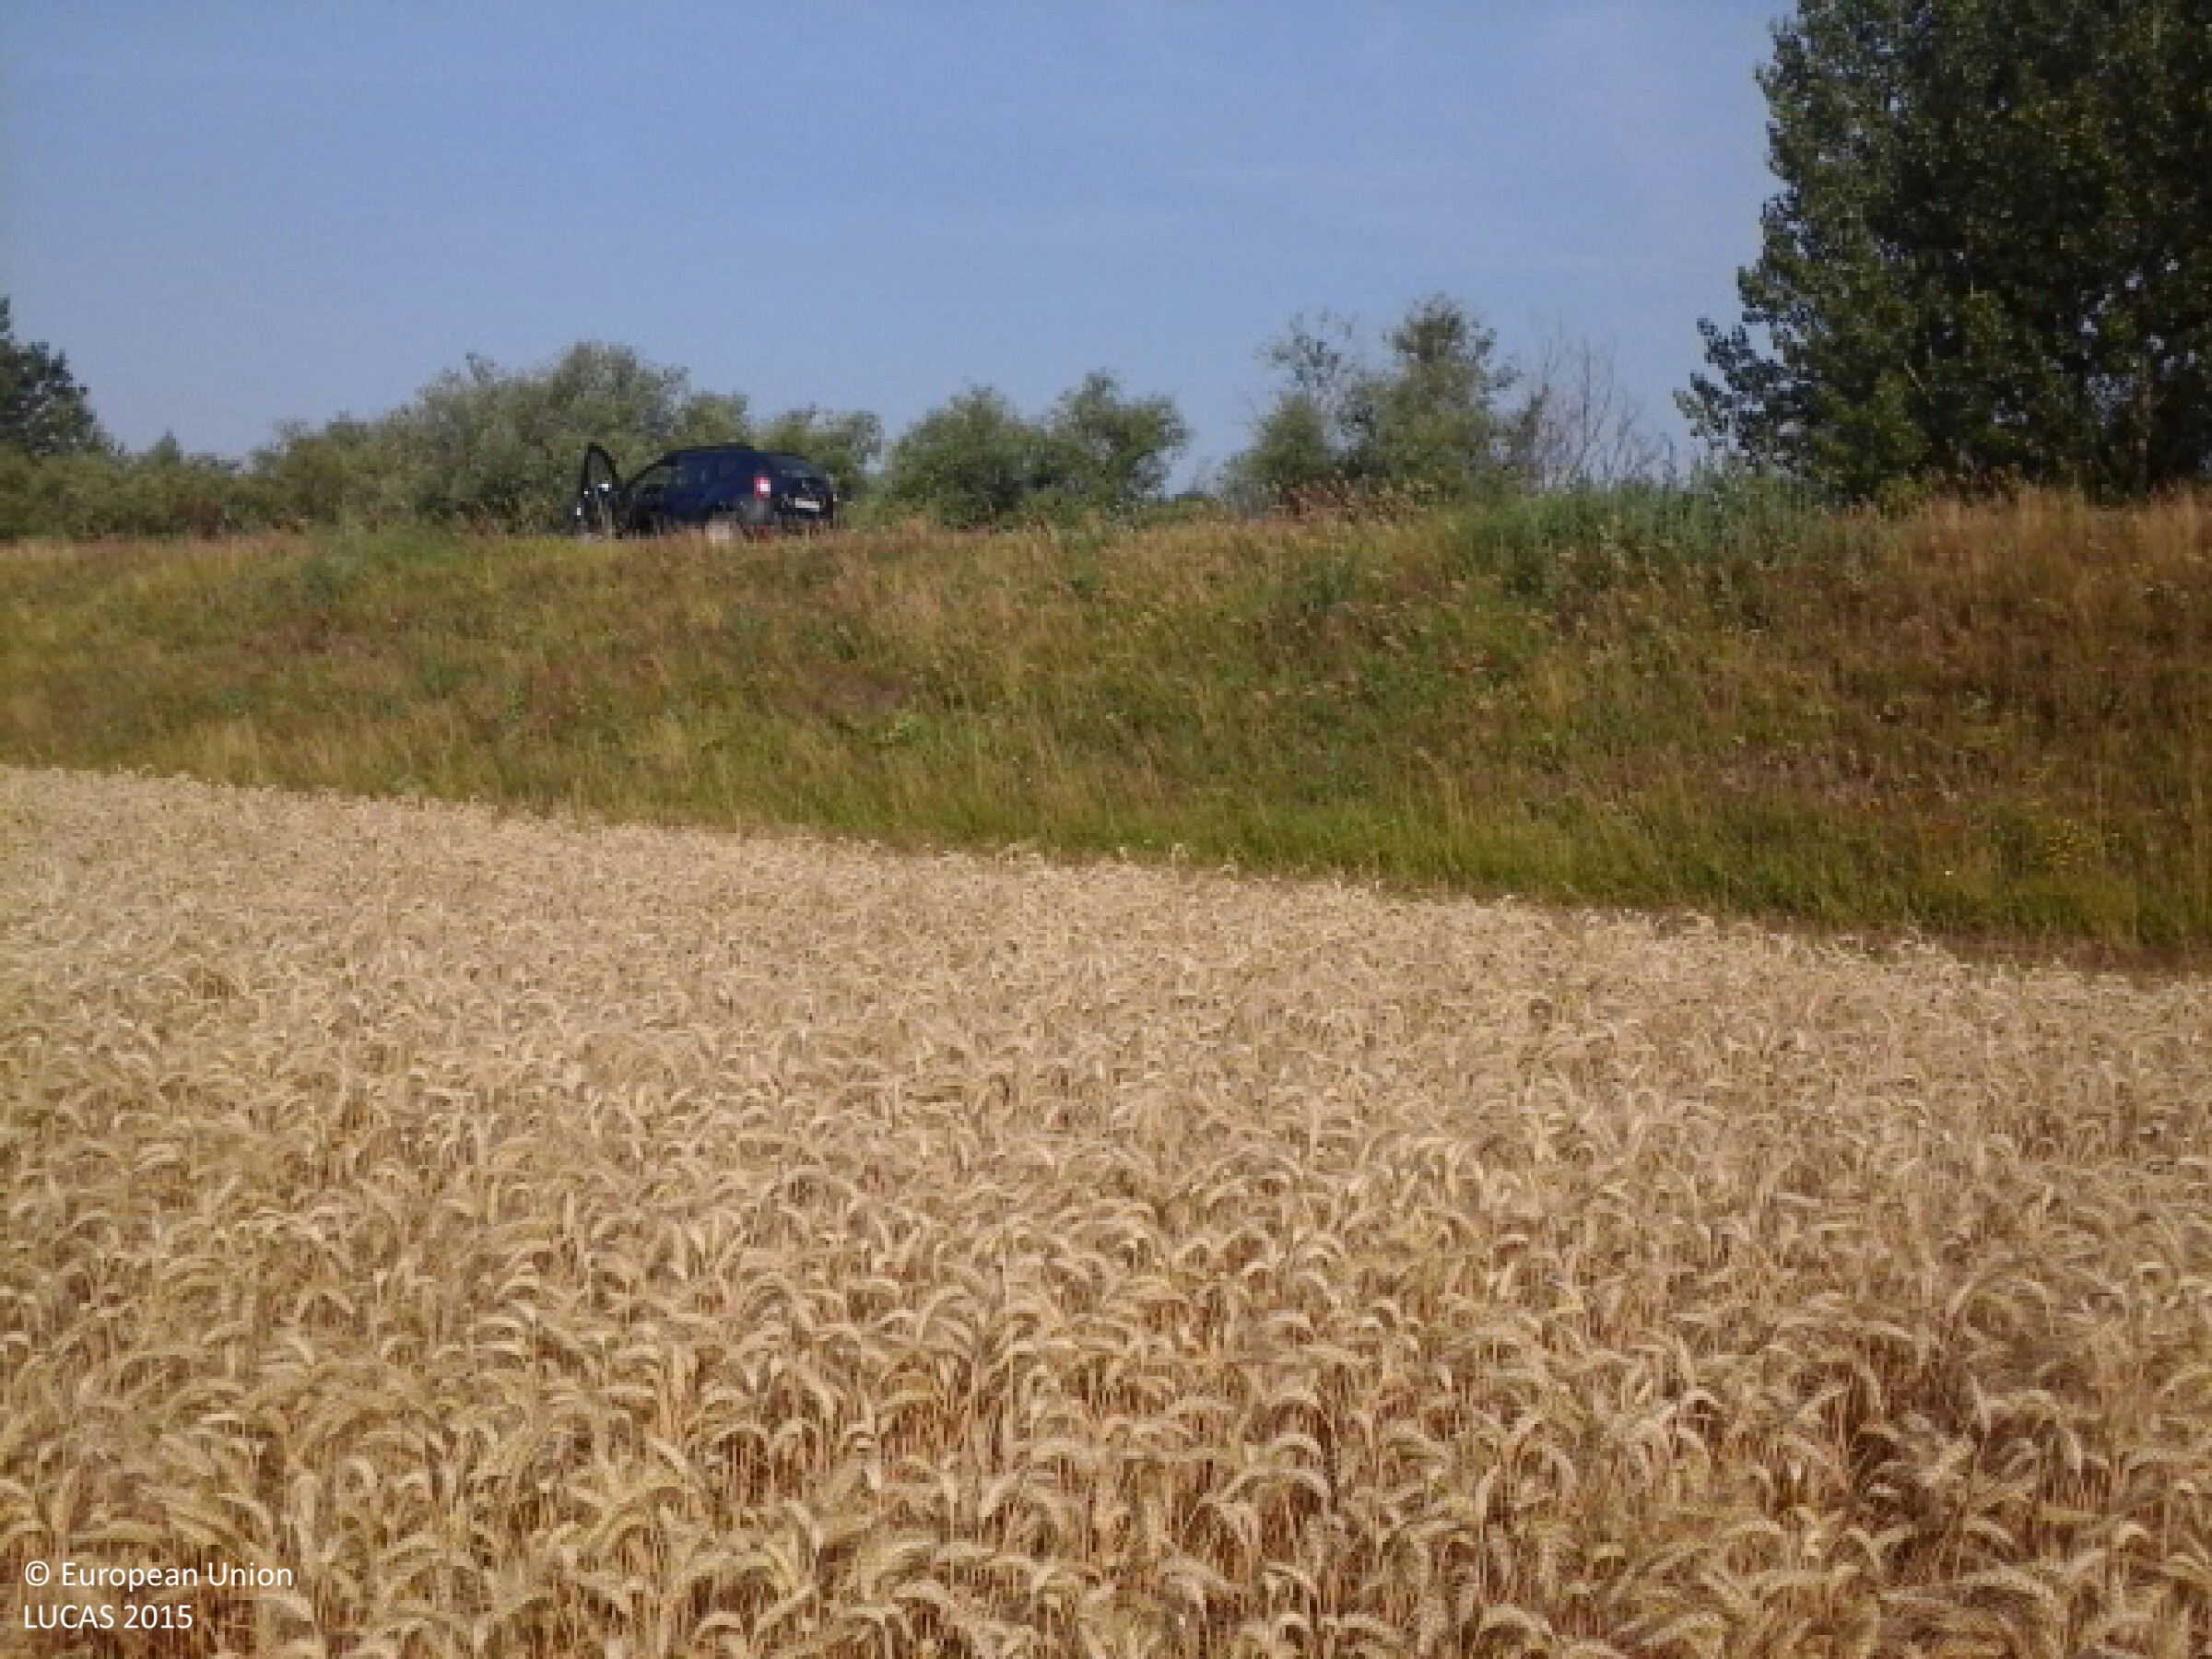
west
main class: Cropland
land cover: Barley
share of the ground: > 75 %
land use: Agriculture (excluding fallow land and kitchen gardens)
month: July
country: HU
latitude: 48.0596
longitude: 21.1103
